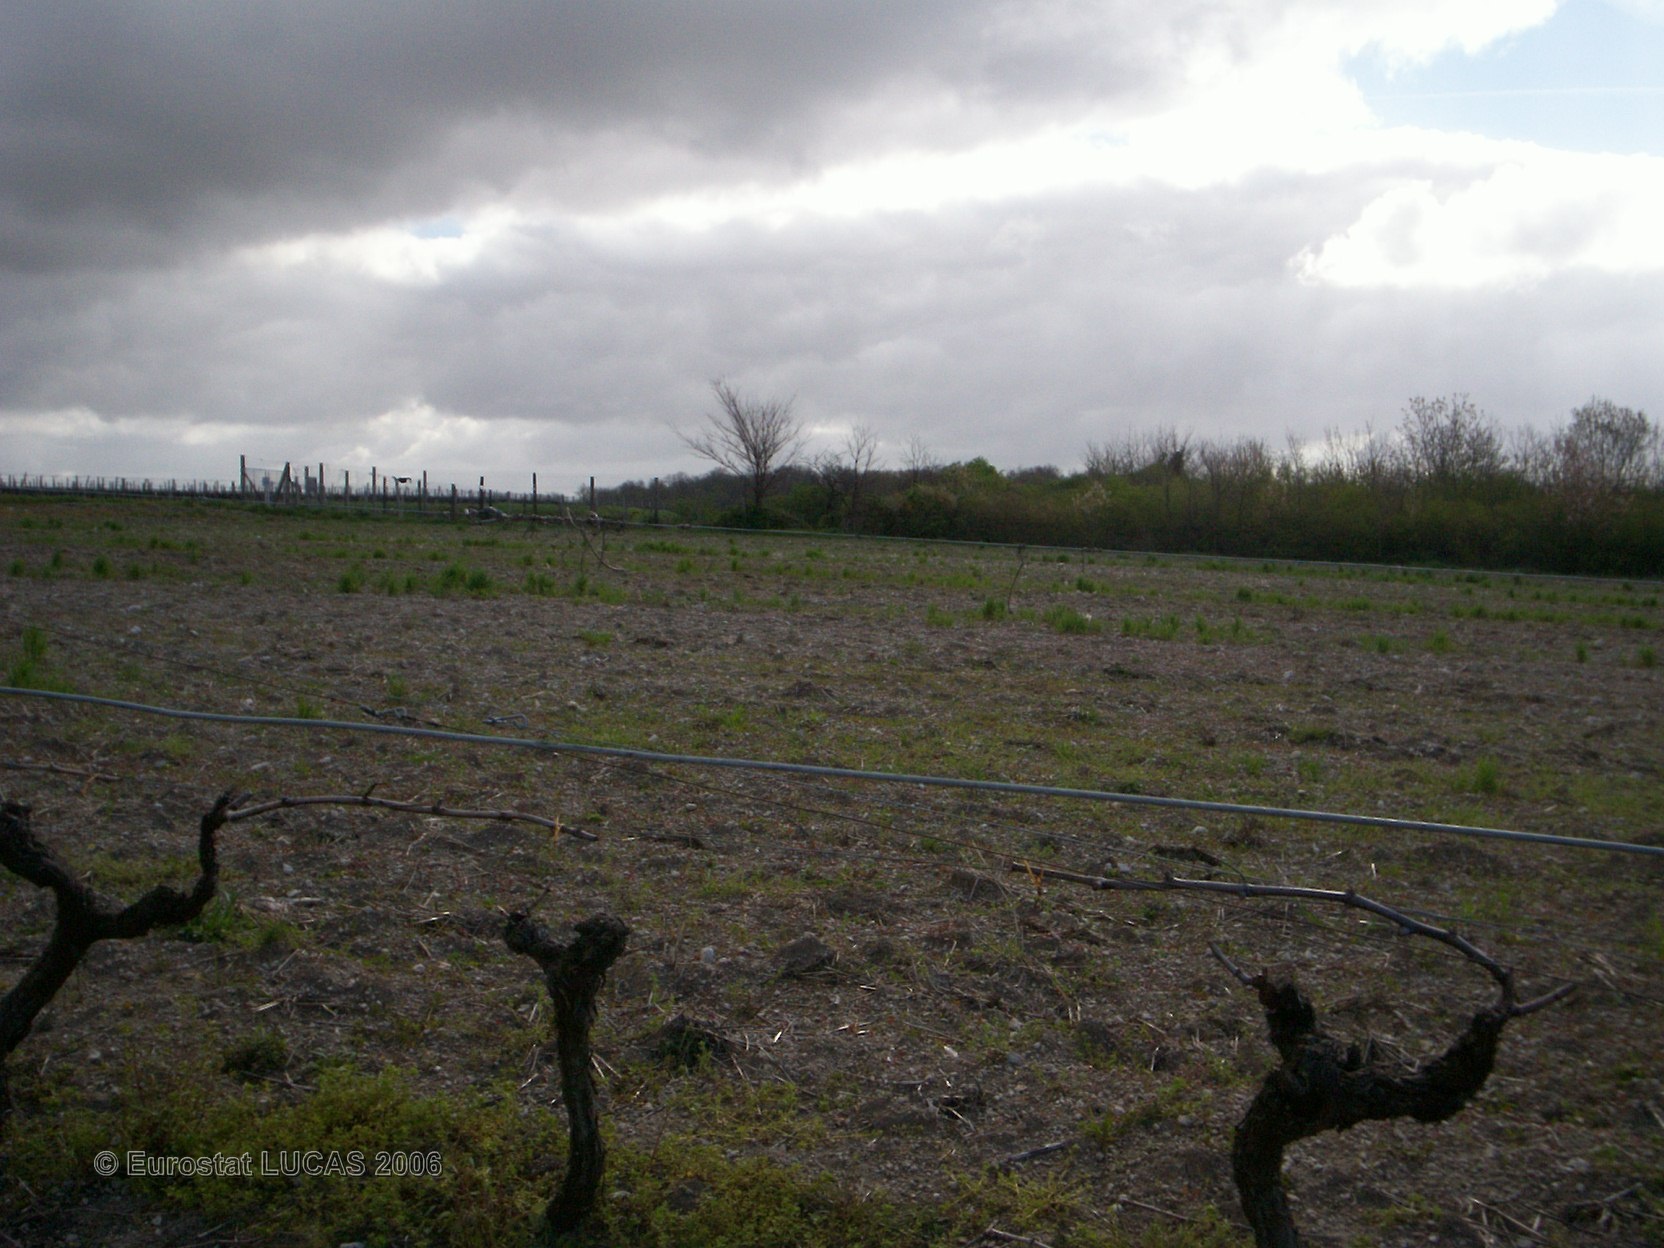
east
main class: Cropland
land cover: Vineyards
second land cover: Grassland with sparse tree/shrub cover
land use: Agriculture (excluding fallow land and kitchen gardens)
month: April
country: FR
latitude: 45.4292
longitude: -0.7216
